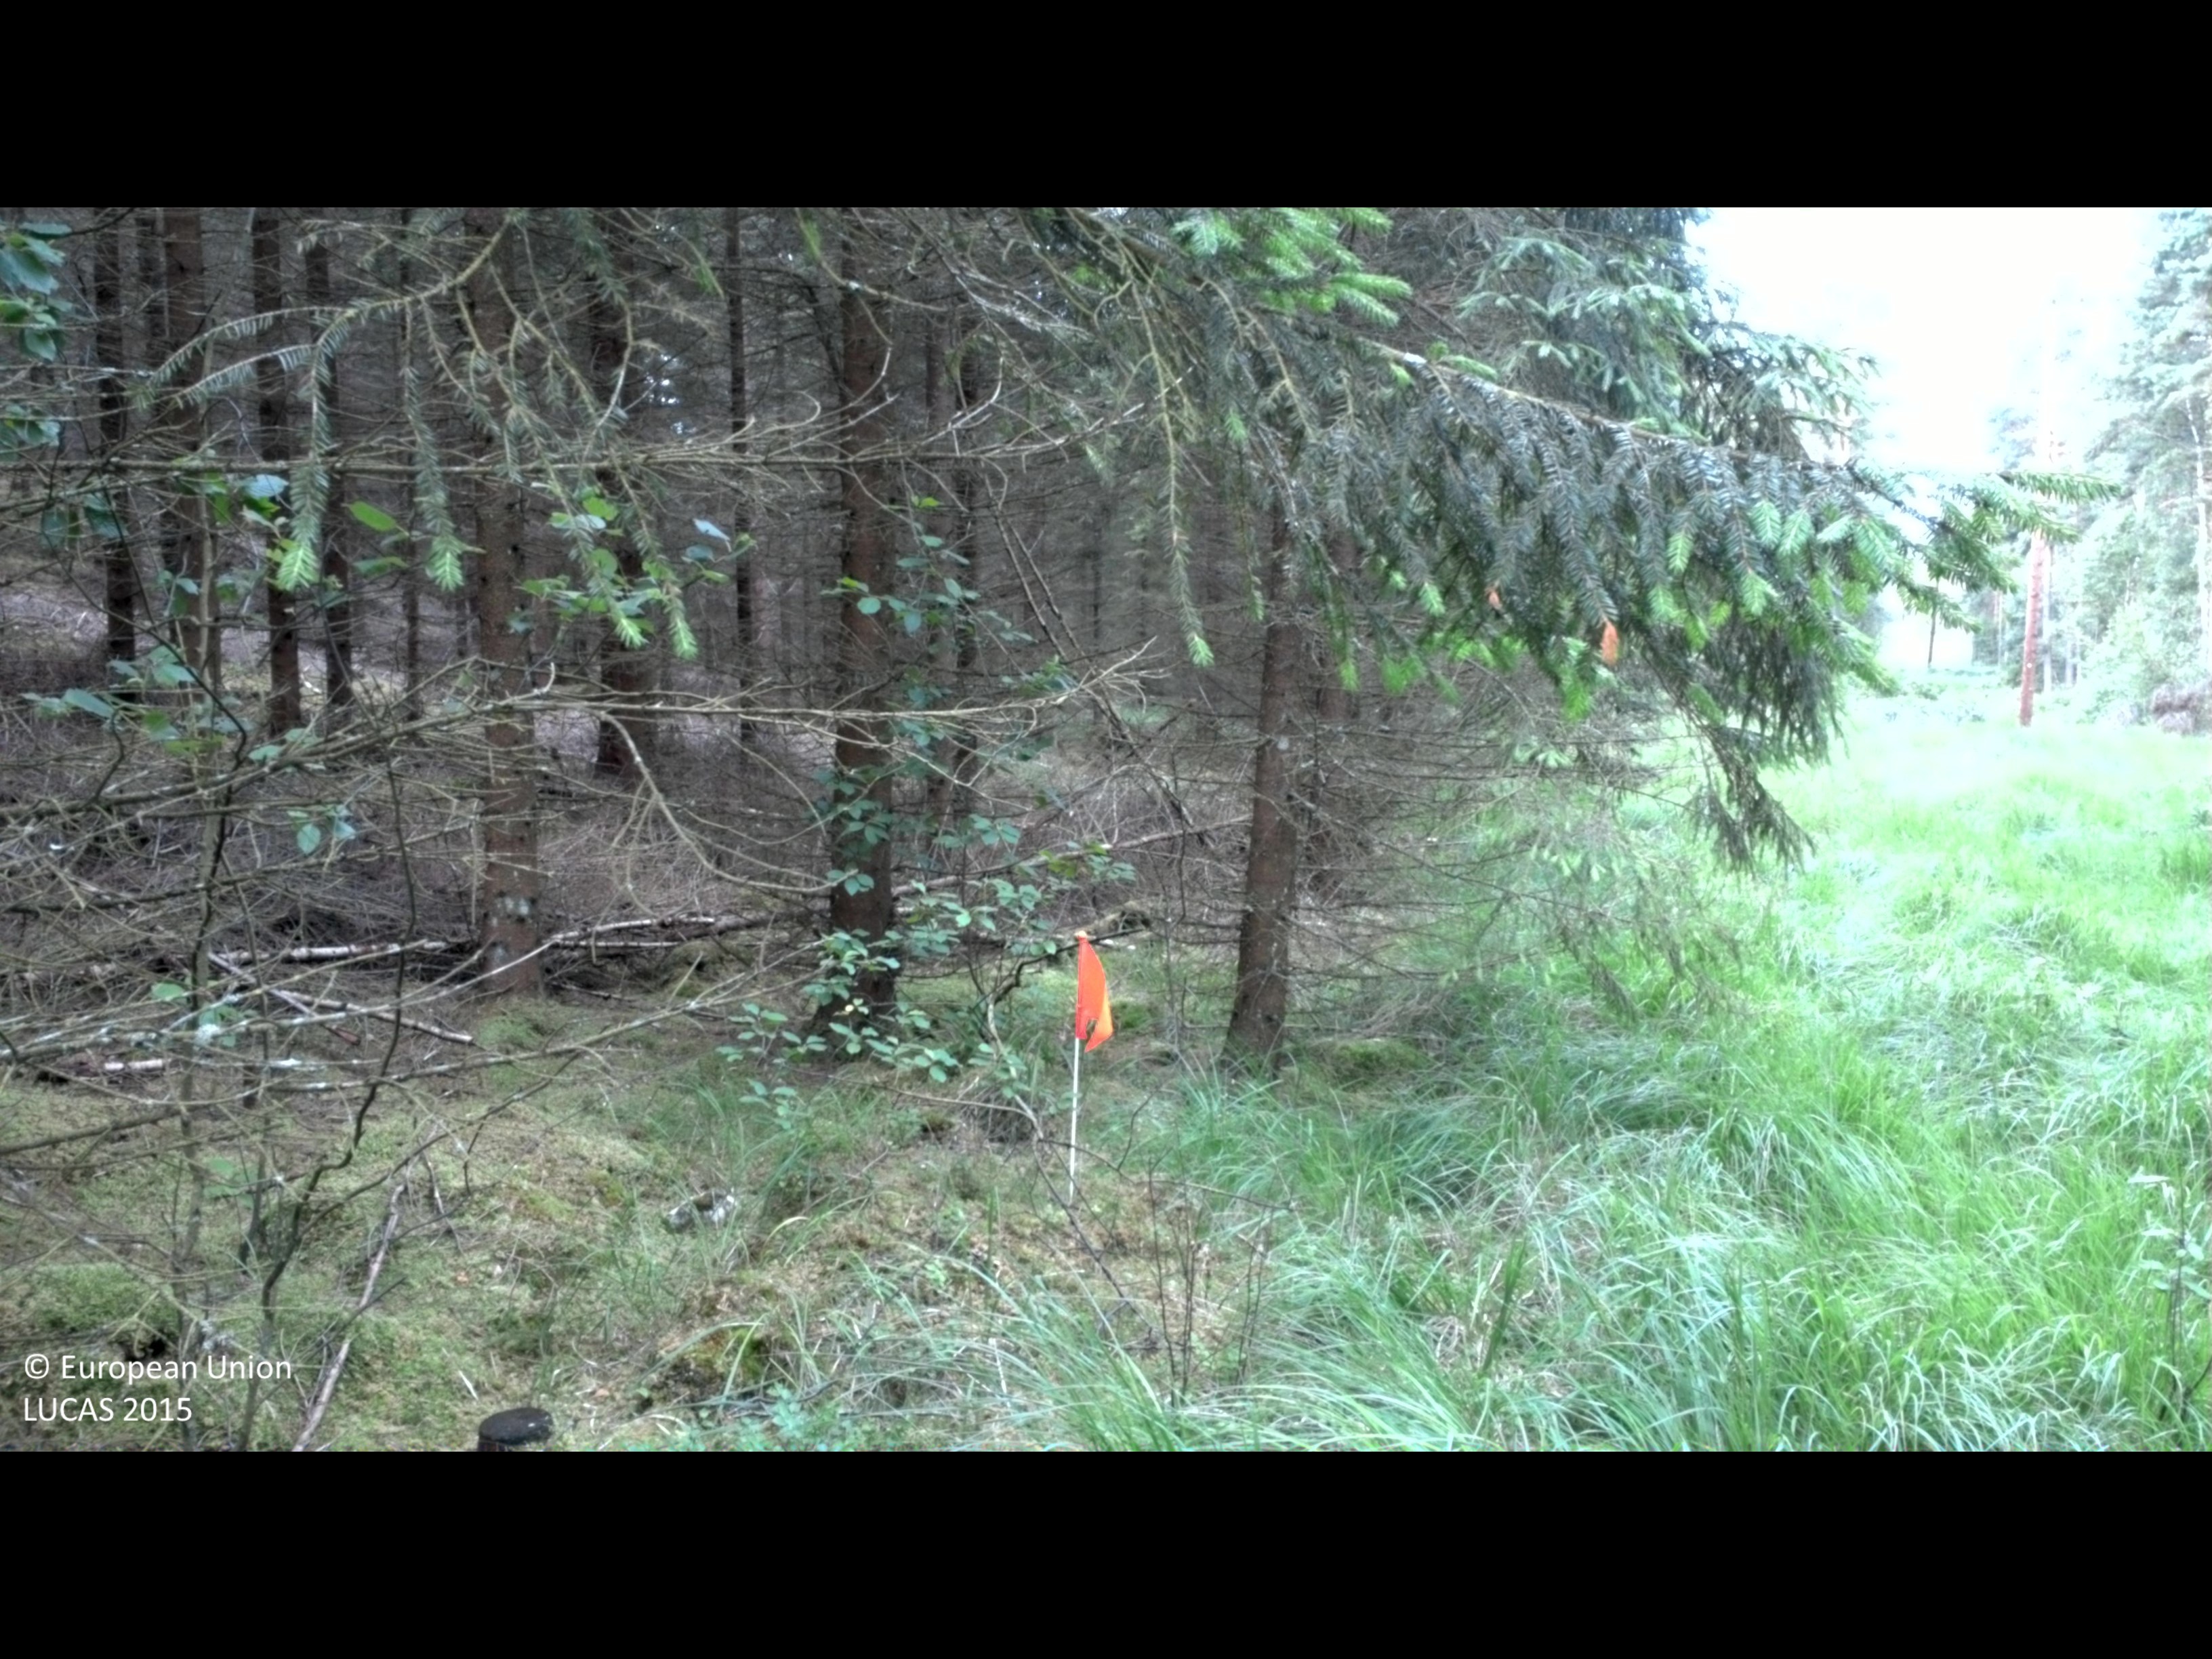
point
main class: Woodland
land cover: Spruce dominated coniferous woodland
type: boreal forest
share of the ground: > 75 %
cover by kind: coniferous forest trees 75 %, lichens and mosses 20 %
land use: Forestry
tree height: > 5 m
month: August
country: SE
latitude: 56.6527
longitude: 13.8299
